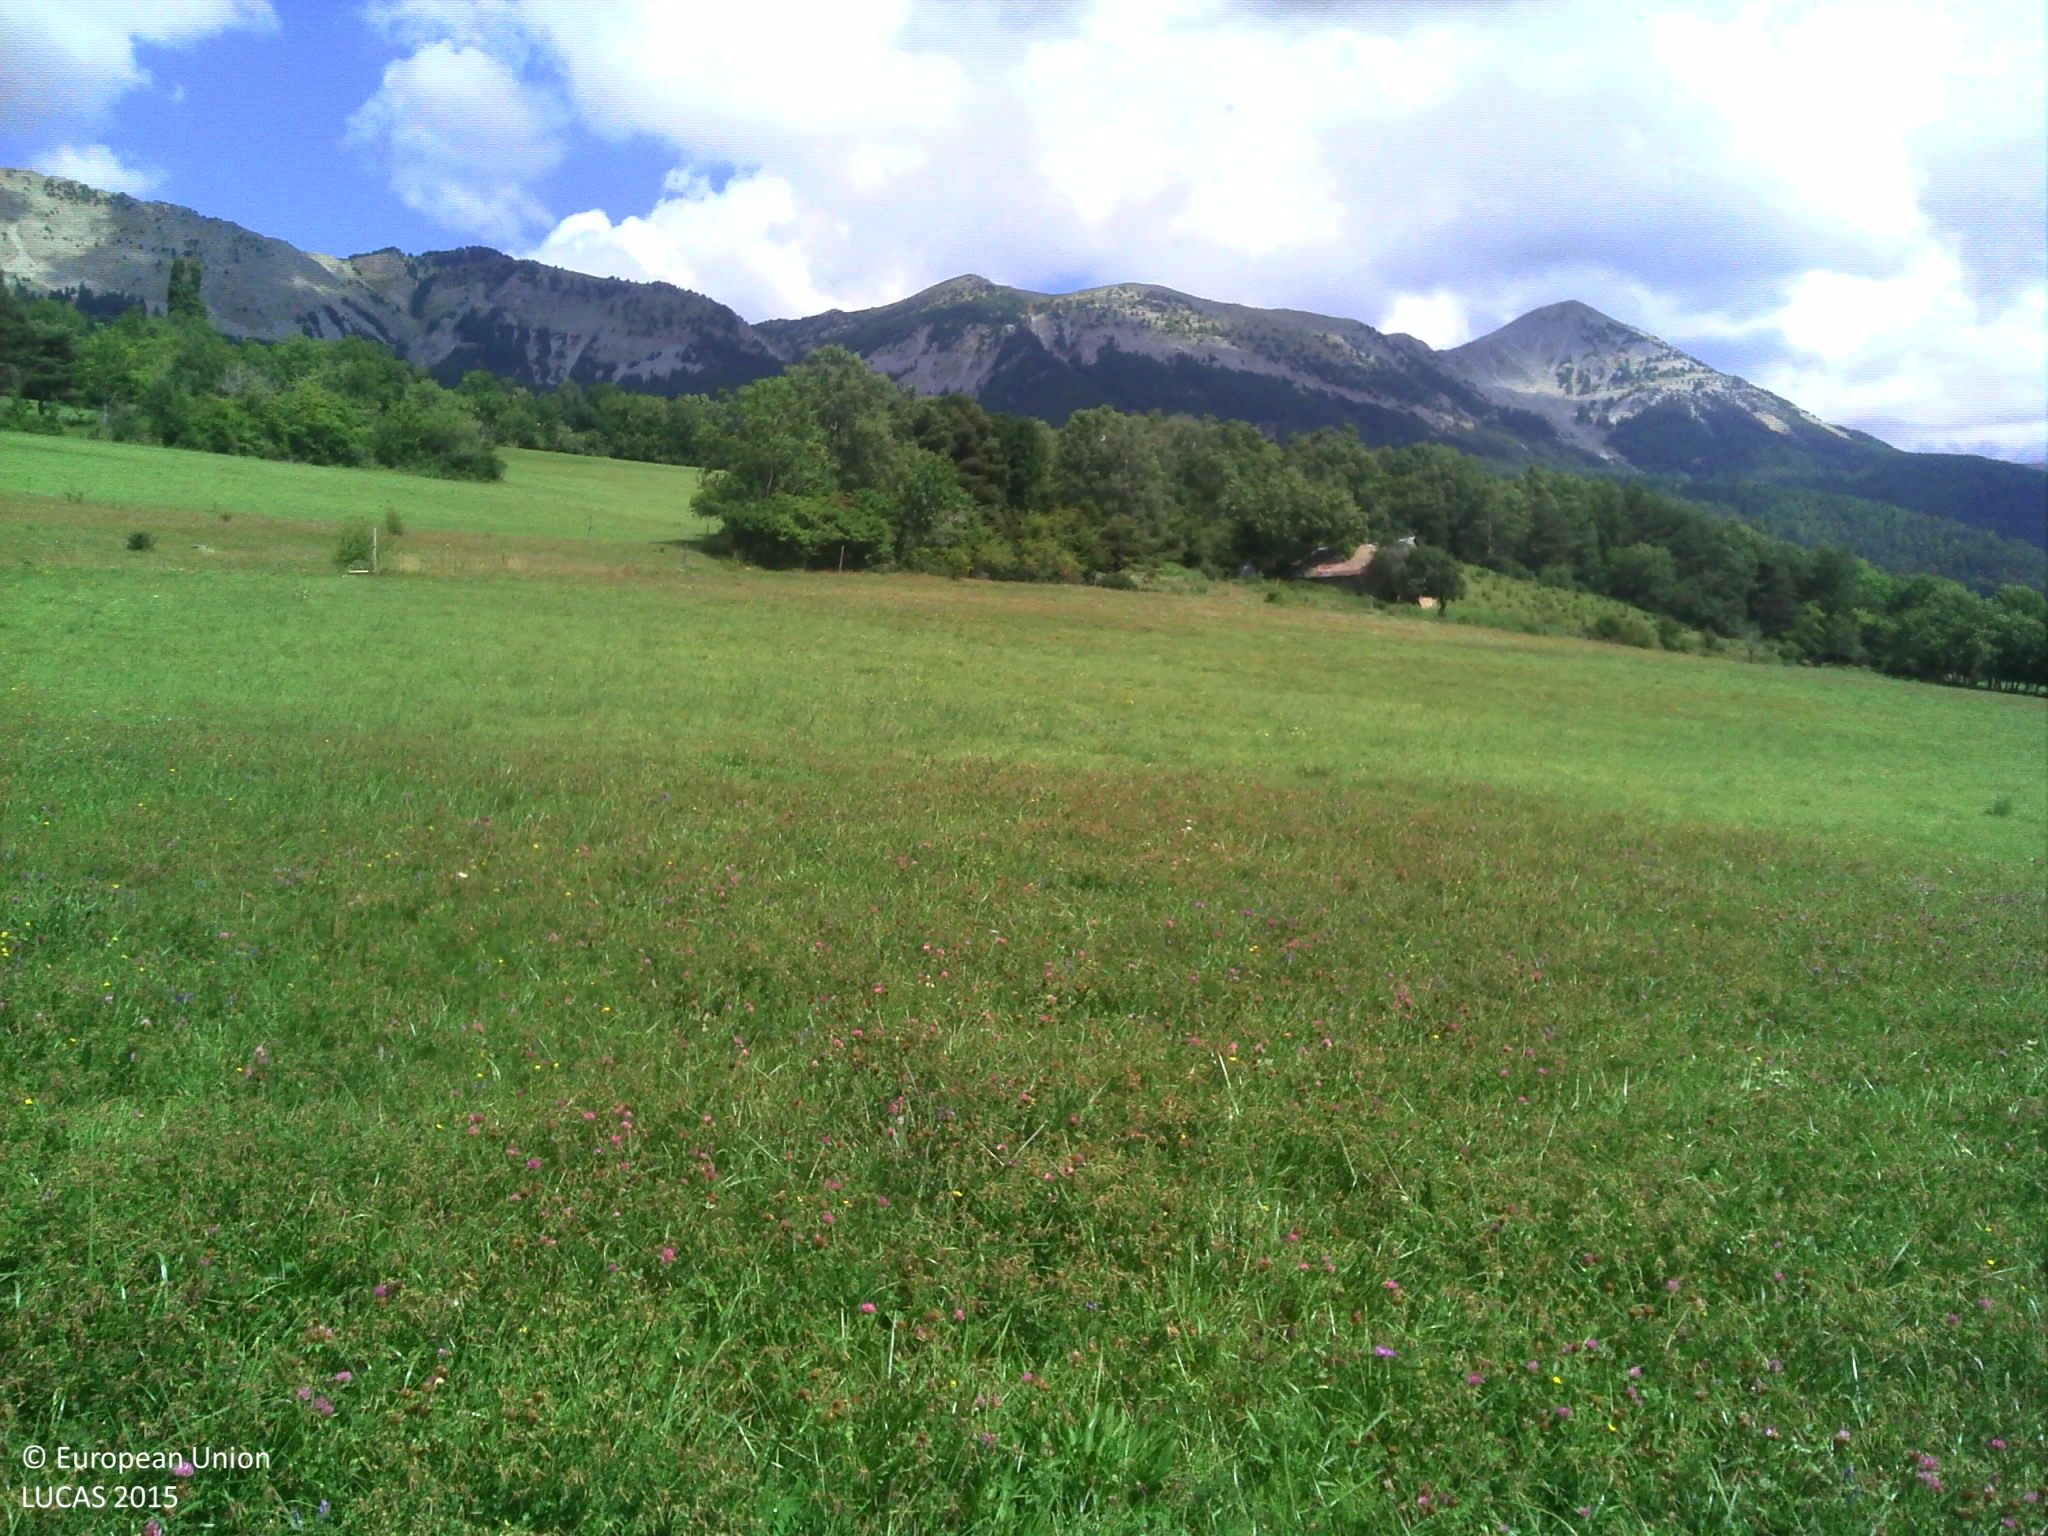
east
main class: Grassland
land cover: Grassland without tree/shrub cover
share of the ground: > 75 %
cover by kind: herbaceous plants 100 %
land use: Agriculture (excluding fallow land and kitchen gardens)
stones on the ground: < 10 %
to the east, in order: Grassland without tree/shrub cover; Fences; Grassland without tree/shrub cover; Tracks; Grassland without tree/shrub cover; Broadleaved woodland; Grassland without tree/shrub cover; Broadleaved woodland; Fences; Grassland without tree/shrub cover
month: August
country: FR
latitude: 44.3768
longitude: 6.3546
